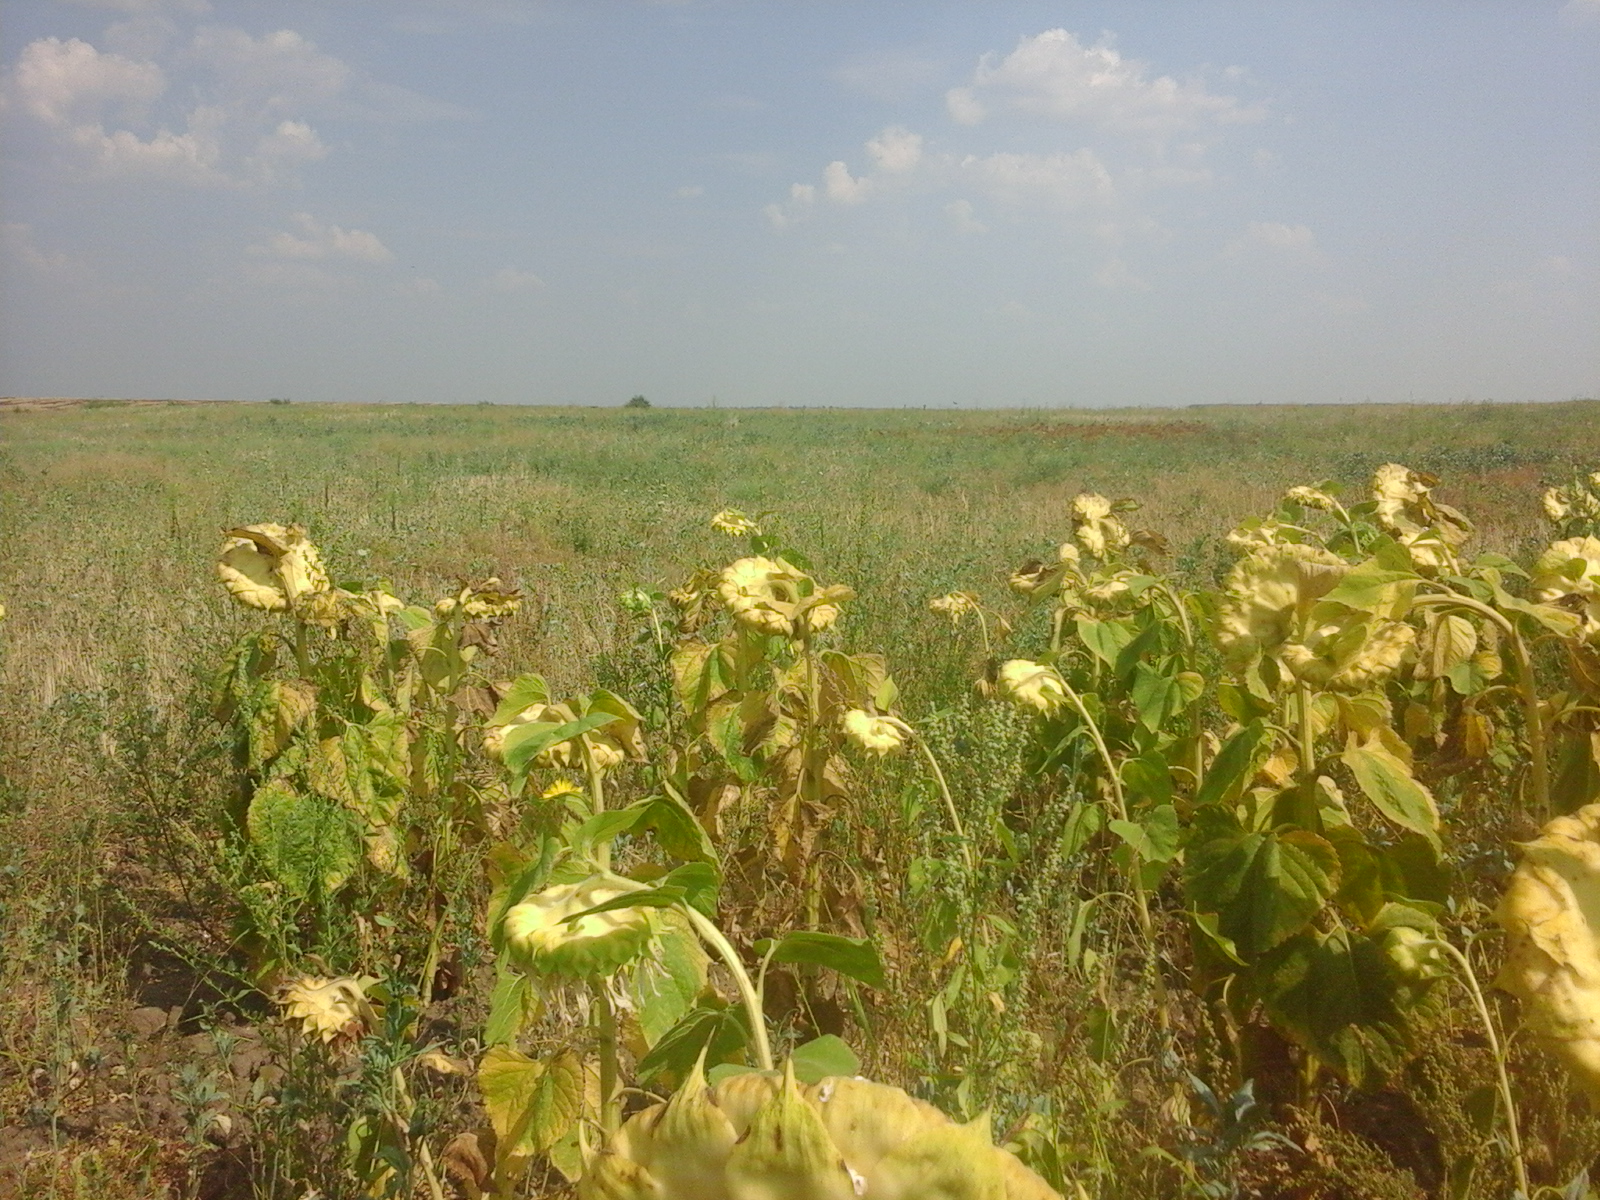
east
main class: Cropland
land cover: Sunflower
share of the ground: > 75 %
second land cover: Spontaneously vegetated surfaces
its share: 50 - 75 %
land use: Agriculture (excluding fallow land and kitchen gardens)
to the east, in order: Sunflower; Spontaneously vegetated surfaces; Grass margins; Rape and turnip rape
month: August
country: RO
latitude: 44.0718
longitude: 23.5985
